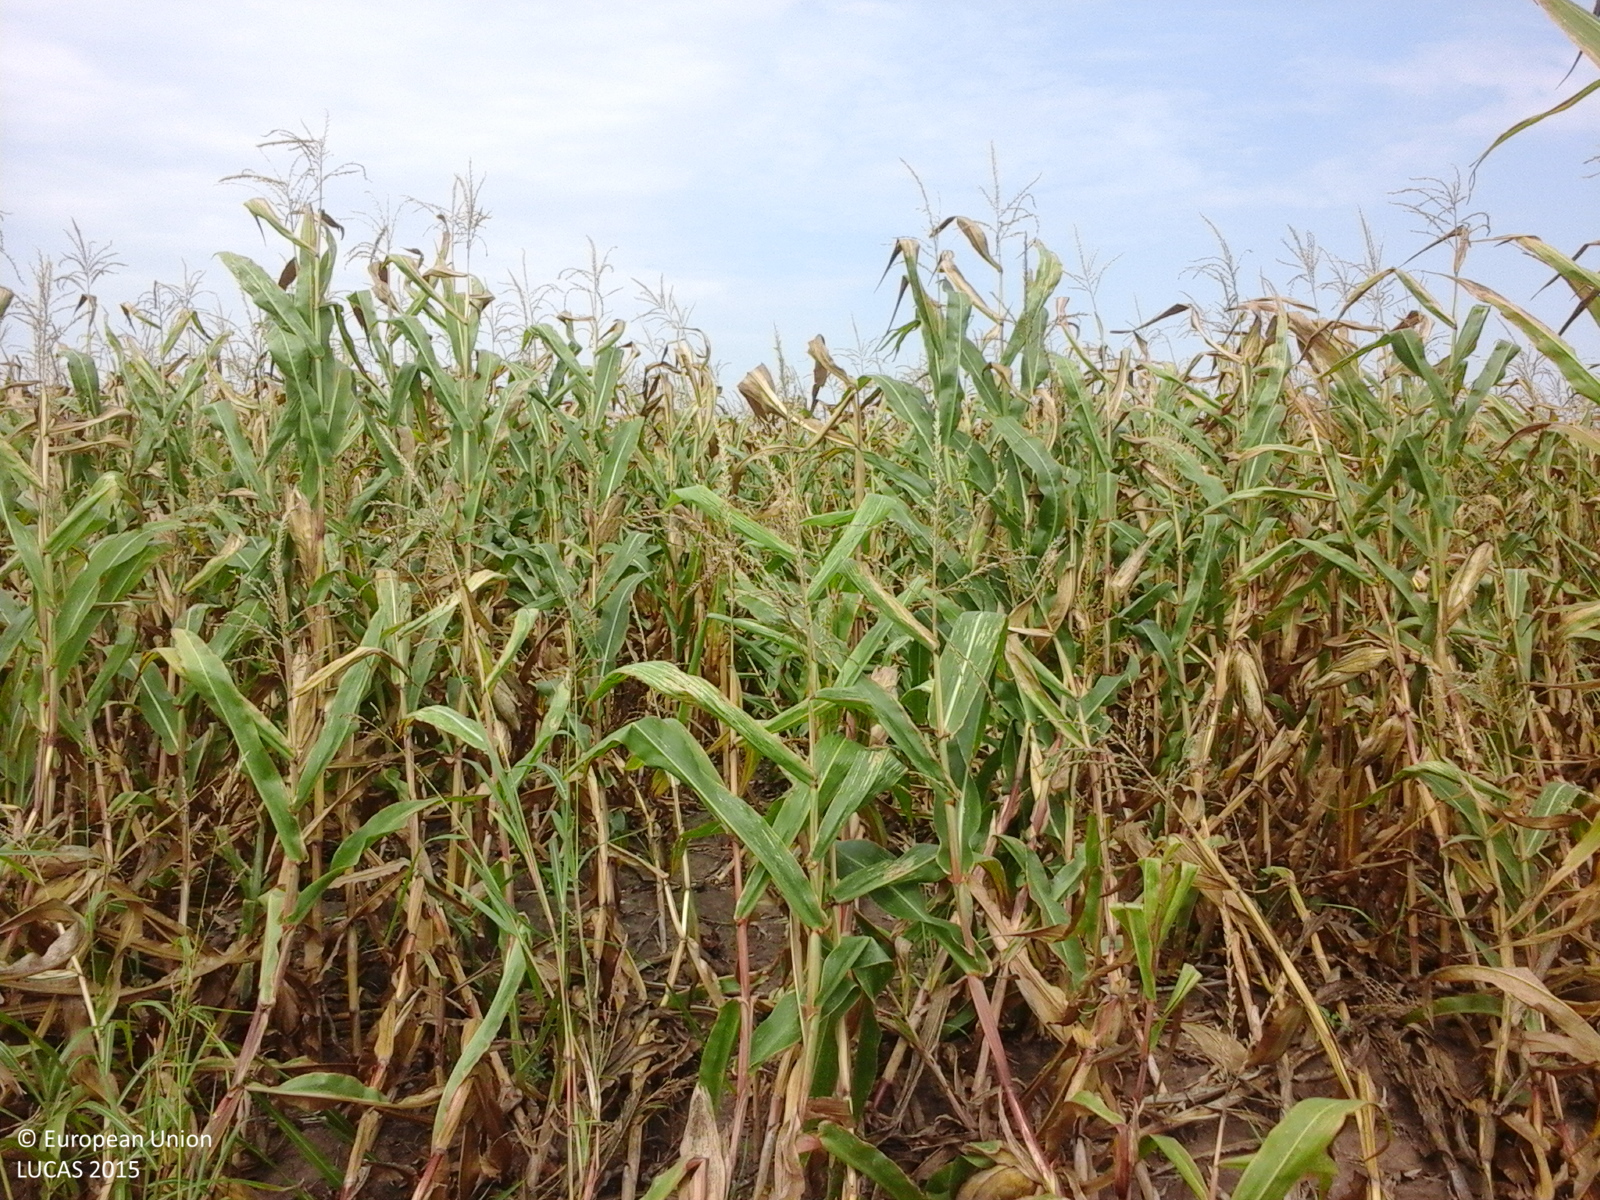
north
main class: Cropland
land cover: Maize
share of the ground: > 75 %
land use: Agriculture (excluding fallow land and kitchen gardens)
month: August
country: RO
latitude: 46.2303
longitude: 20.8820
